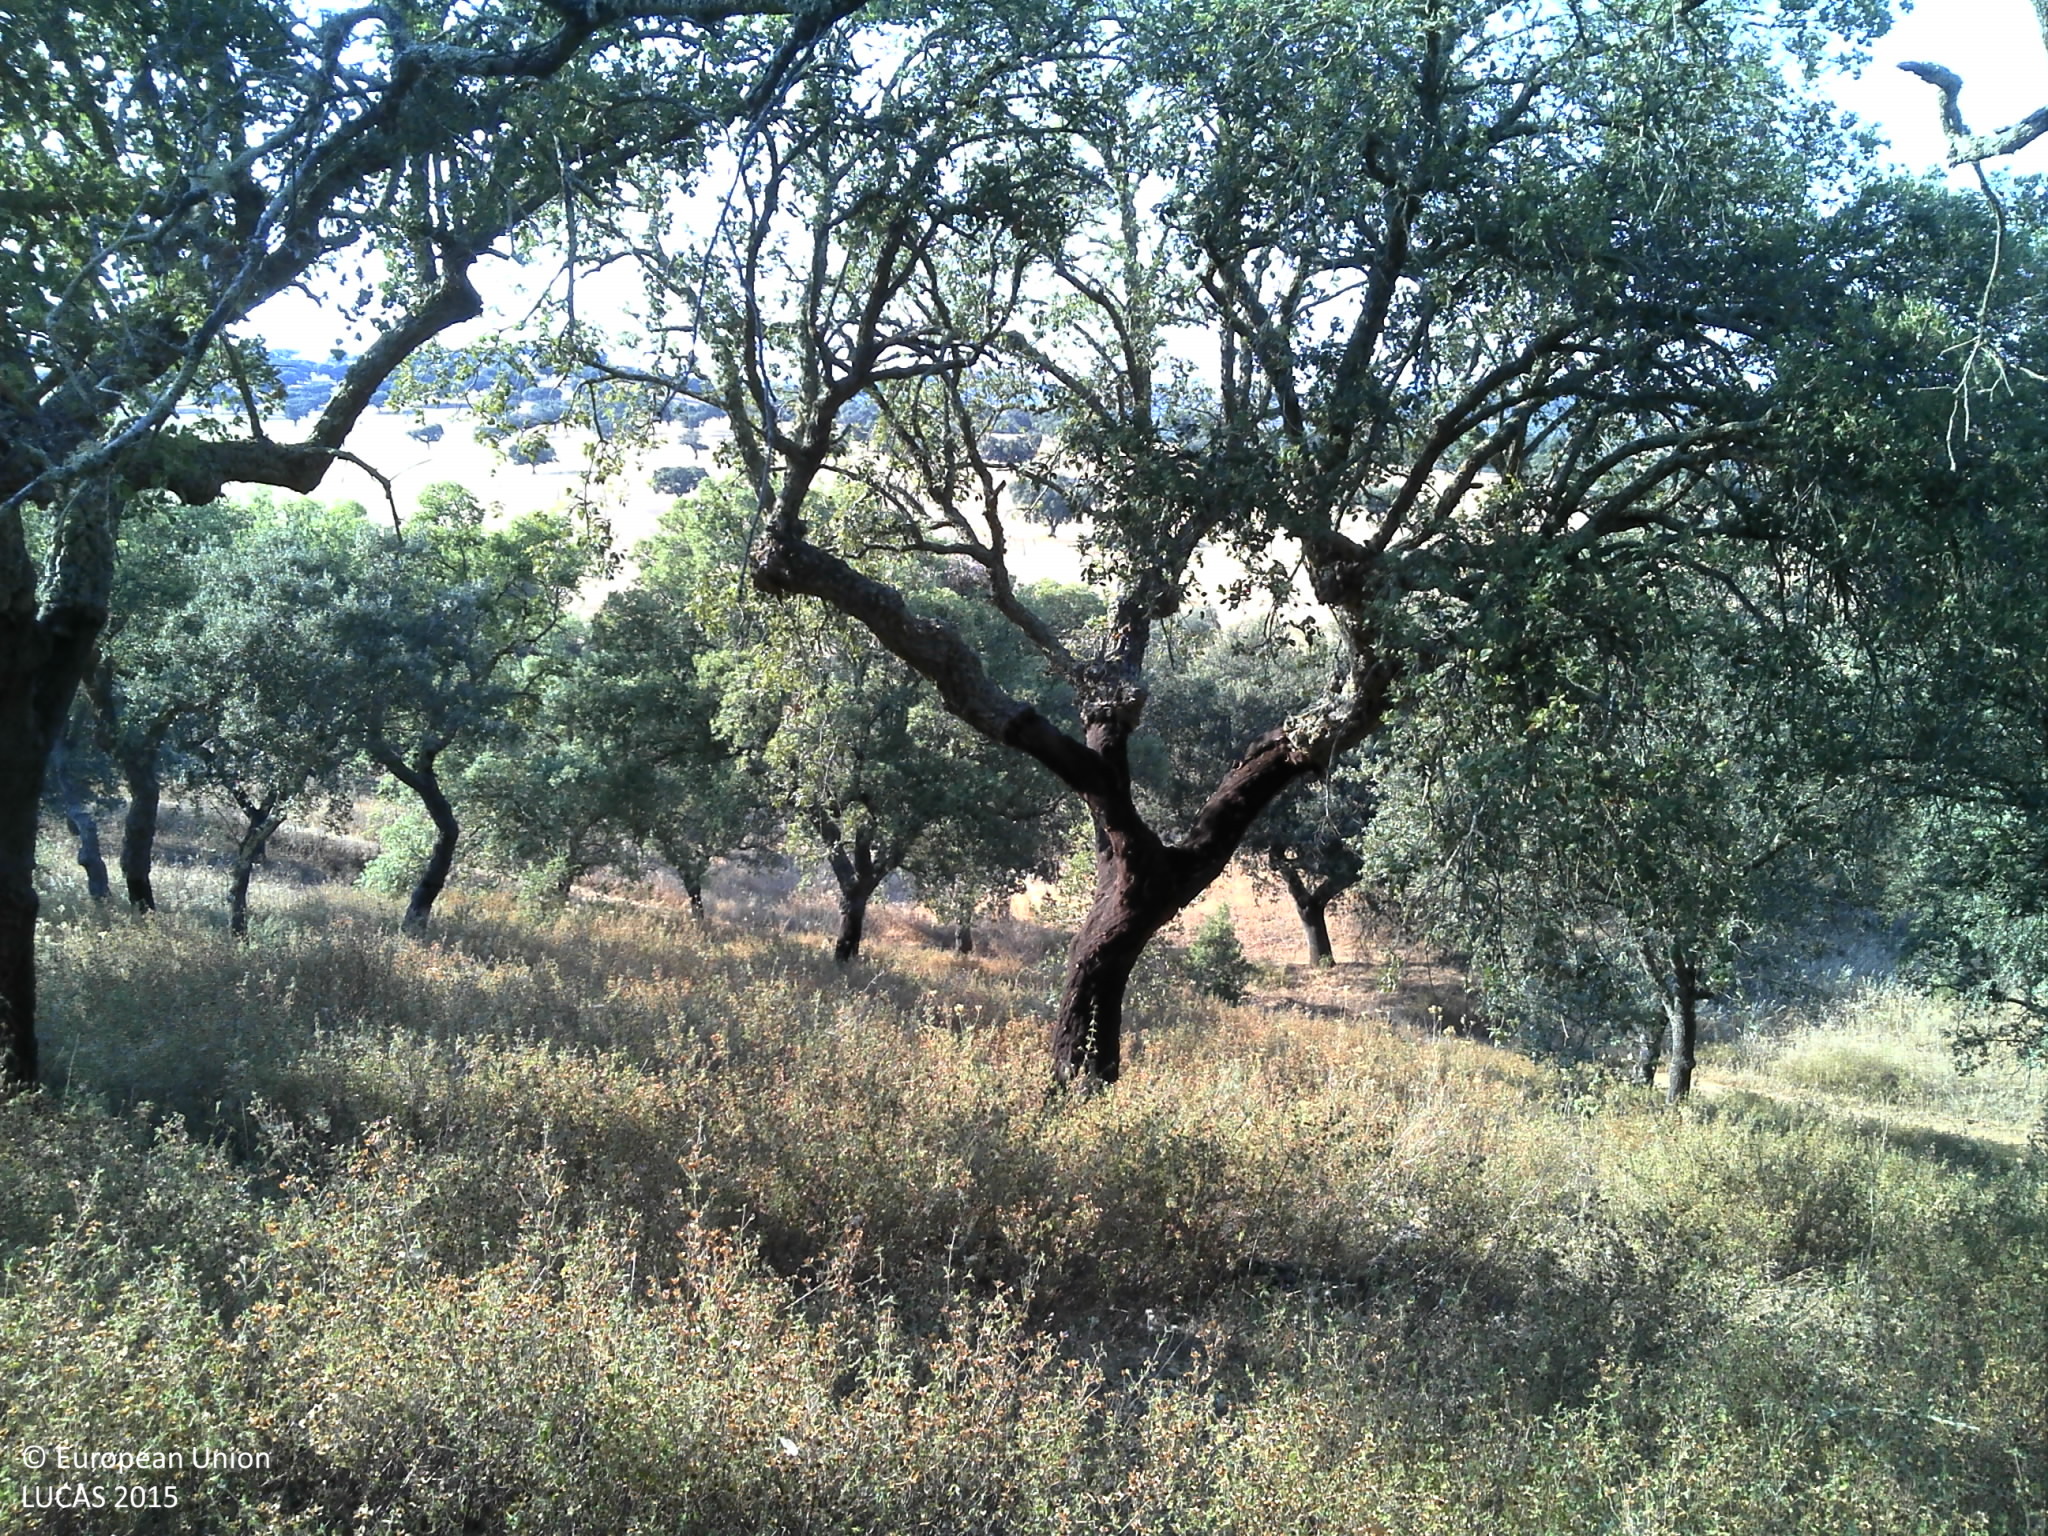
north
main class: Woodland
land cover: Broadleaved woodland
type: broadleaved evergreen forest
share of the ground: 50 - 75 %
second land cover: Grassland without tree/shrub cover
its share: 50 - 75 %
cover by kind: broadleaved forest trees 50 %, herbaceous plants 50 %
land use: Forestry
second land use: Agriculture (excluding fallow land and kitchen gardens)
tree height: > 5 m
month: June
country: PT
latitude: 38.3101
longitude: -7.6051
